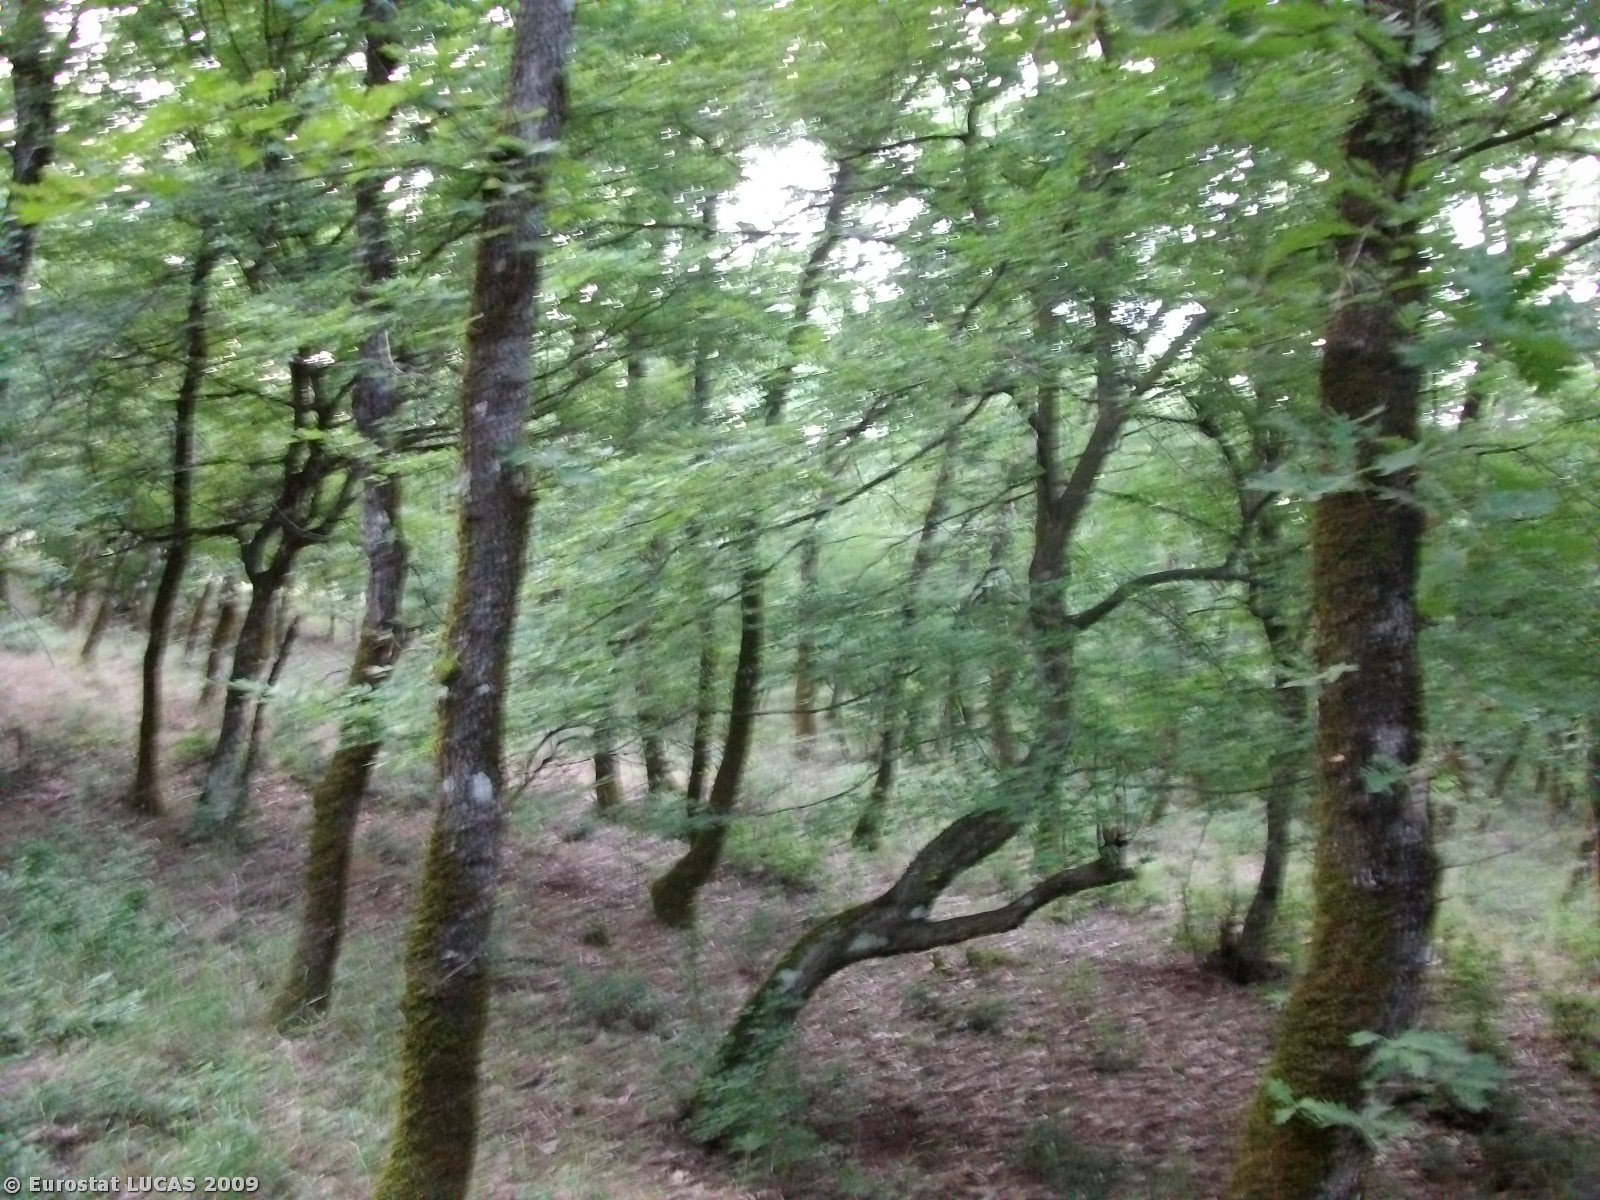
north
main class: Woodland
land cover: Broadleaved woodland
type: broadleaved evergreen forest
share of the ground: > 75 %
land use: Forestry
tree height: > 5 m
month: July
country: GR
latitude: 39.5395
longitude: 21.6059
